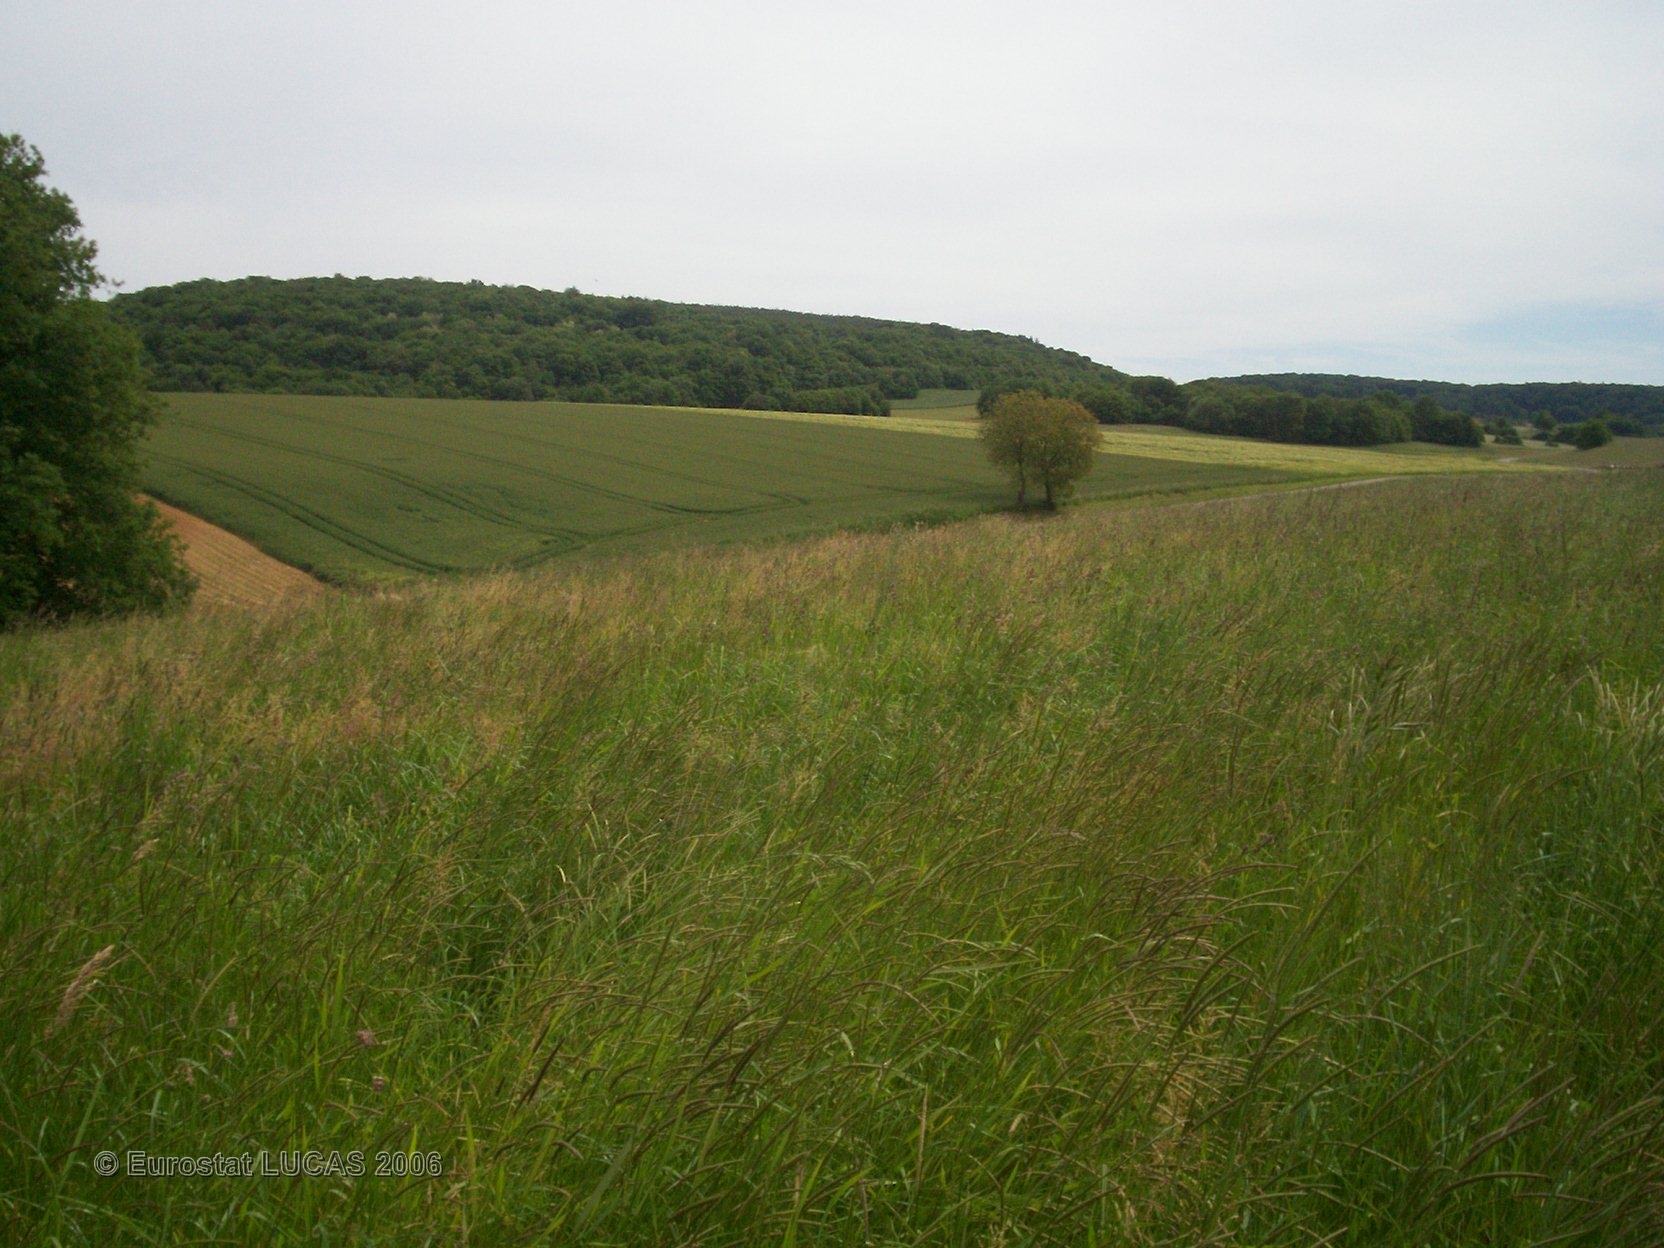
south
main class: Grassland
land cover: Grassland with sparse tree/shrub cover
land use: Agriculture (excluding fallow land and kitchen gardens)
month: June
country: FR
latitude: 47.4845
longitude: 6.0067
